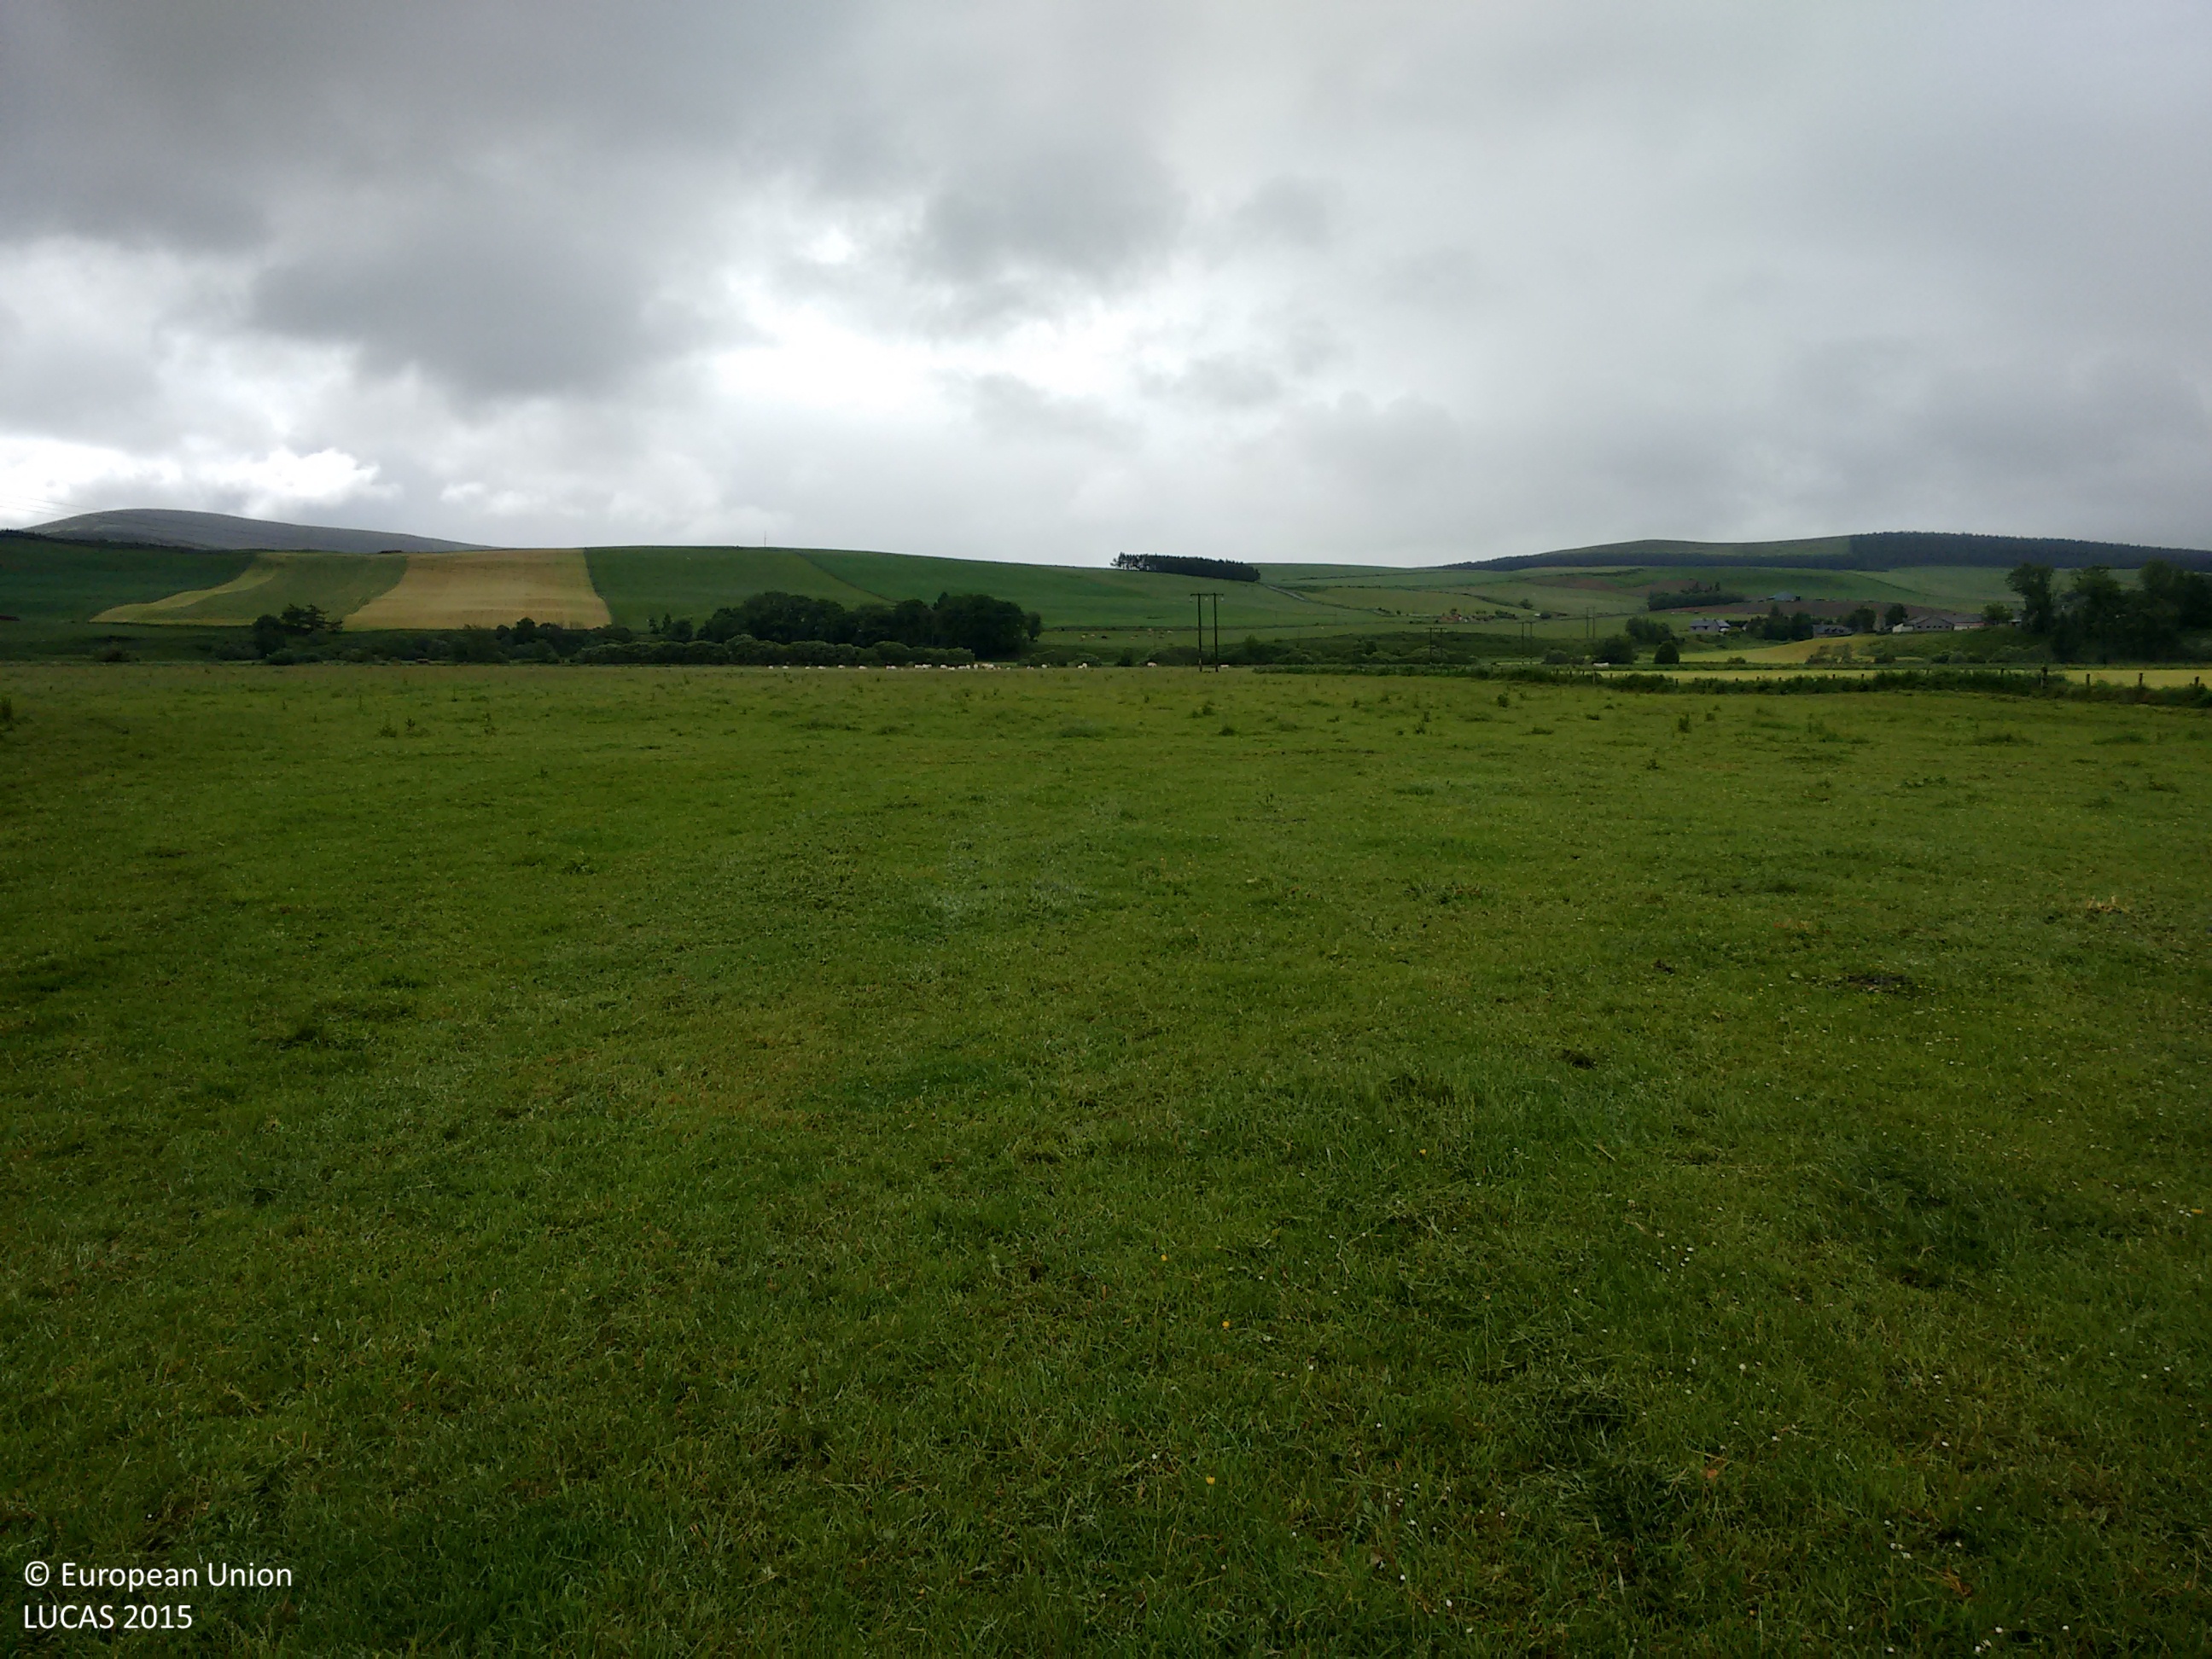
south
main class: Grassland
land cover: Grassland without tree/shrub cover
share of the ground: > 75 %
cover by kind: herbaceous plants 100 %
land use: Agriculture (excluding fallow land and kitchen gardens)
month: July
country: GB
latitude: 57.2087
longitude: -2.9249
